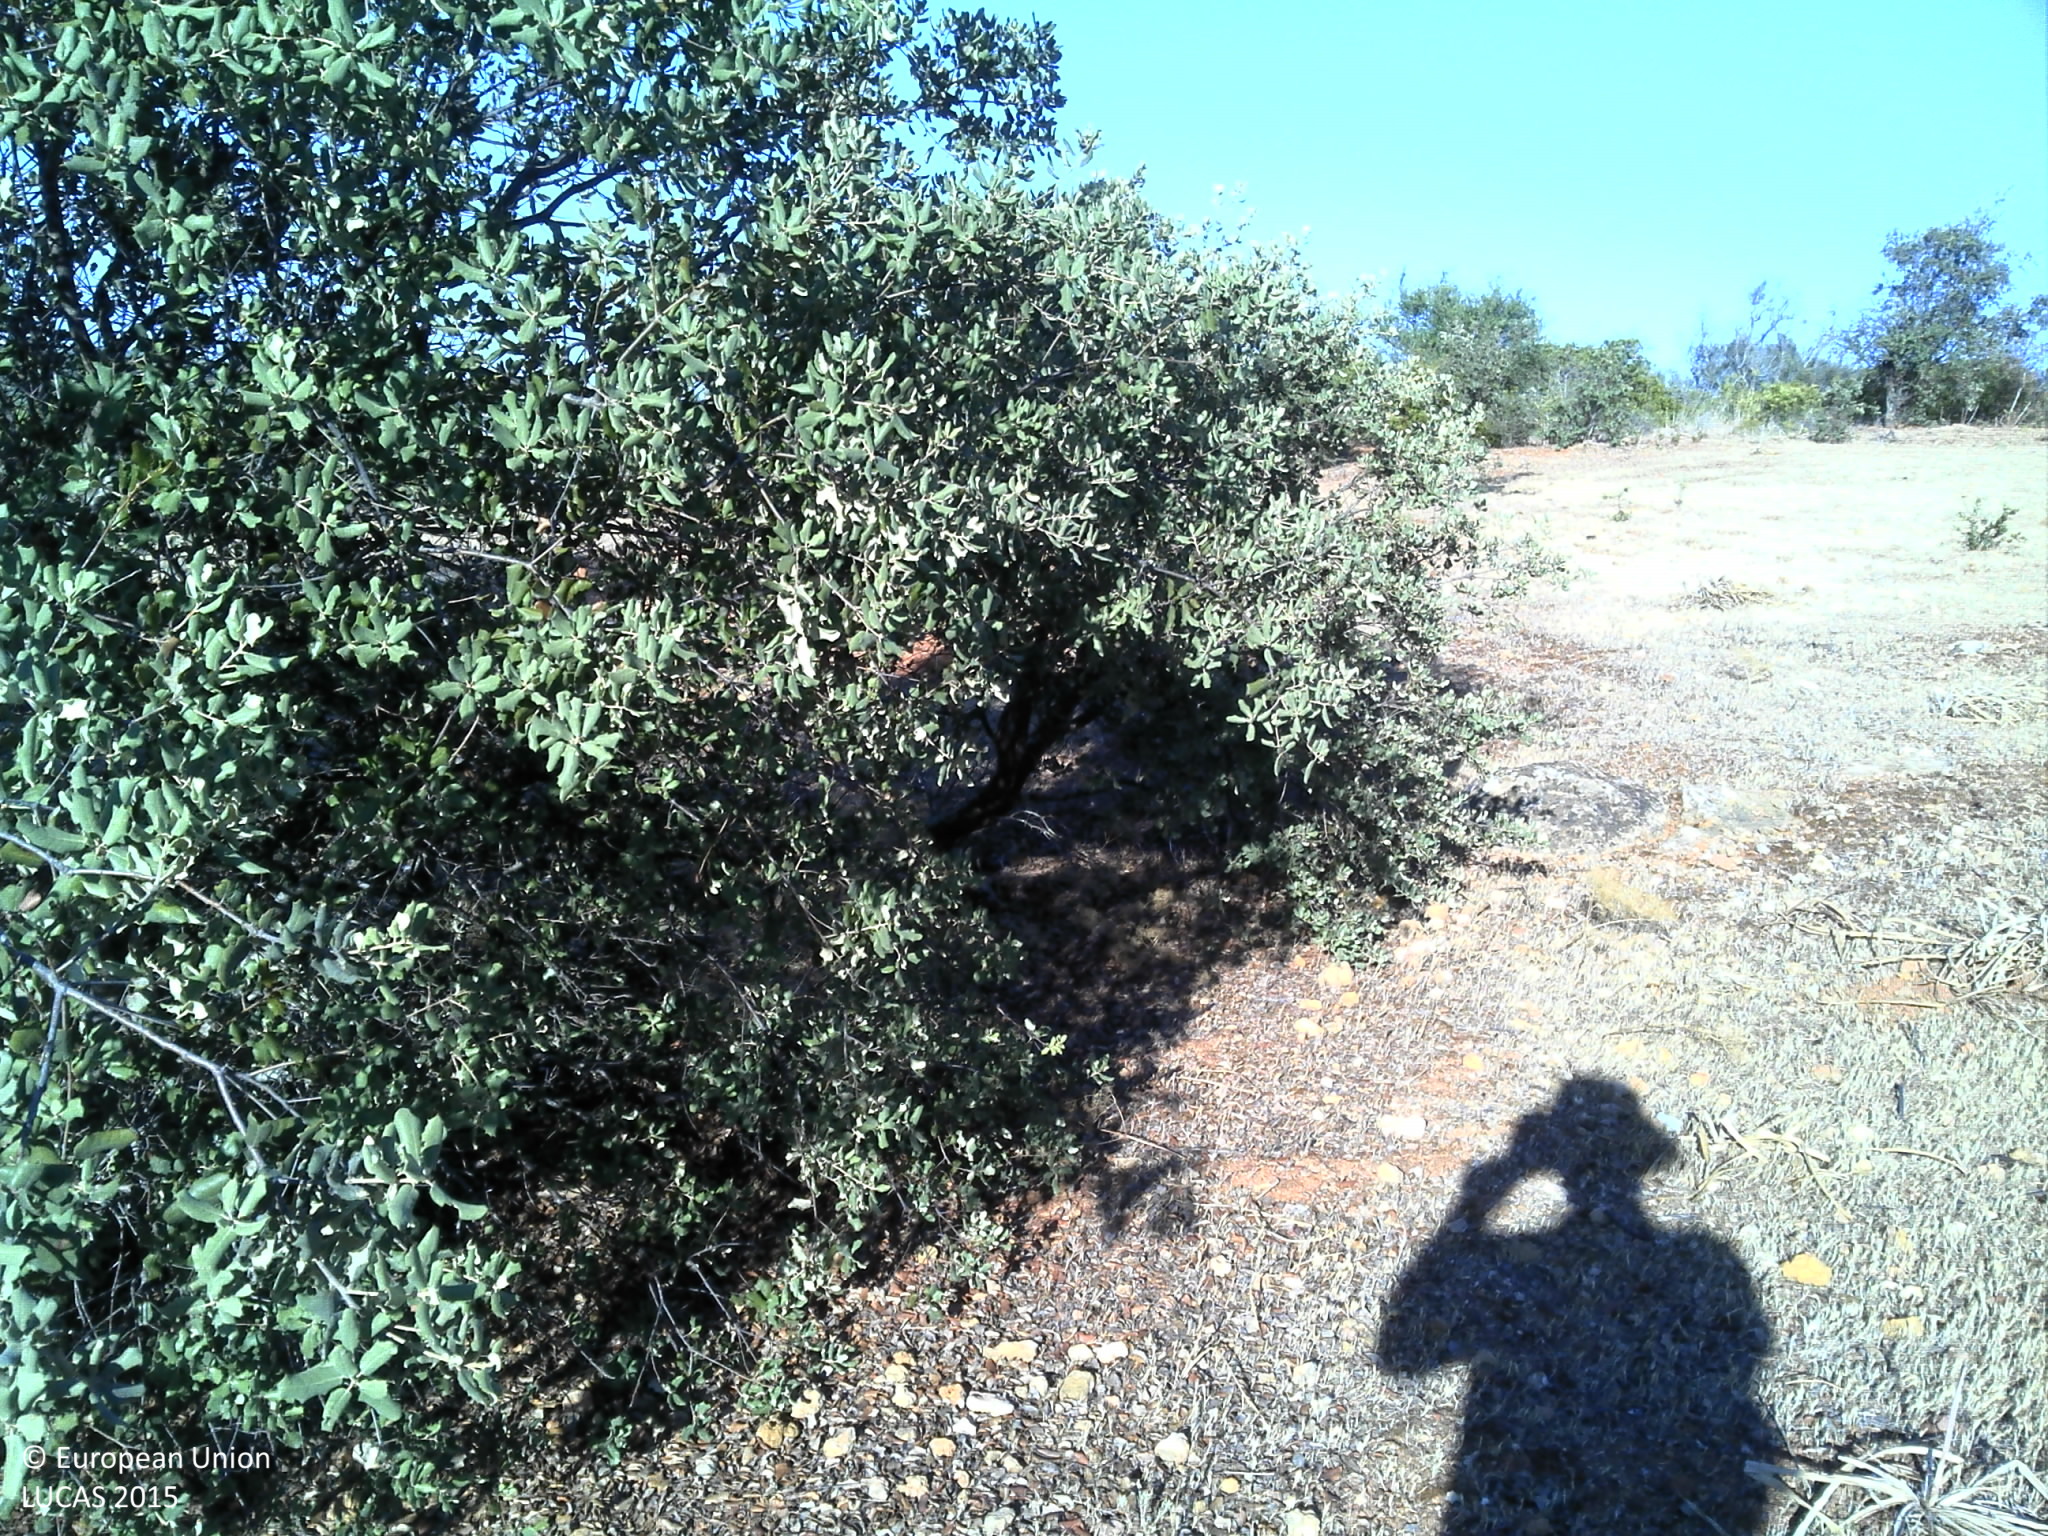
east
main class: Woodland
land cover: Broadleaved woodland
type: broadleaved evergreen forest
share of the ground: 10 - 25 %
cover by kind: unconsolidated bare surface 50 %, broadleaved forest trees 25 %, herbaceous plants 25 %
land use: Forestry
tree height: < 5 m
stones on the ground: < 10 %
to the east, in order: Broadleaved woodland; Shrubland with sparse tree cover; Dry stone walls; Shrubland with sparse tree cover; Dry stone walls; Shrubland with sparse tree cover; Artificial constructions in urban areas; Shrubland with sparse tree cover; Olive groves; Grass margins; Electric lines; Tracks; Dry stone walls; Olive groves; Shrubland with sparse tree cover
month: June
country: PT
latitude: 37.0736
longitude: -7.7895
